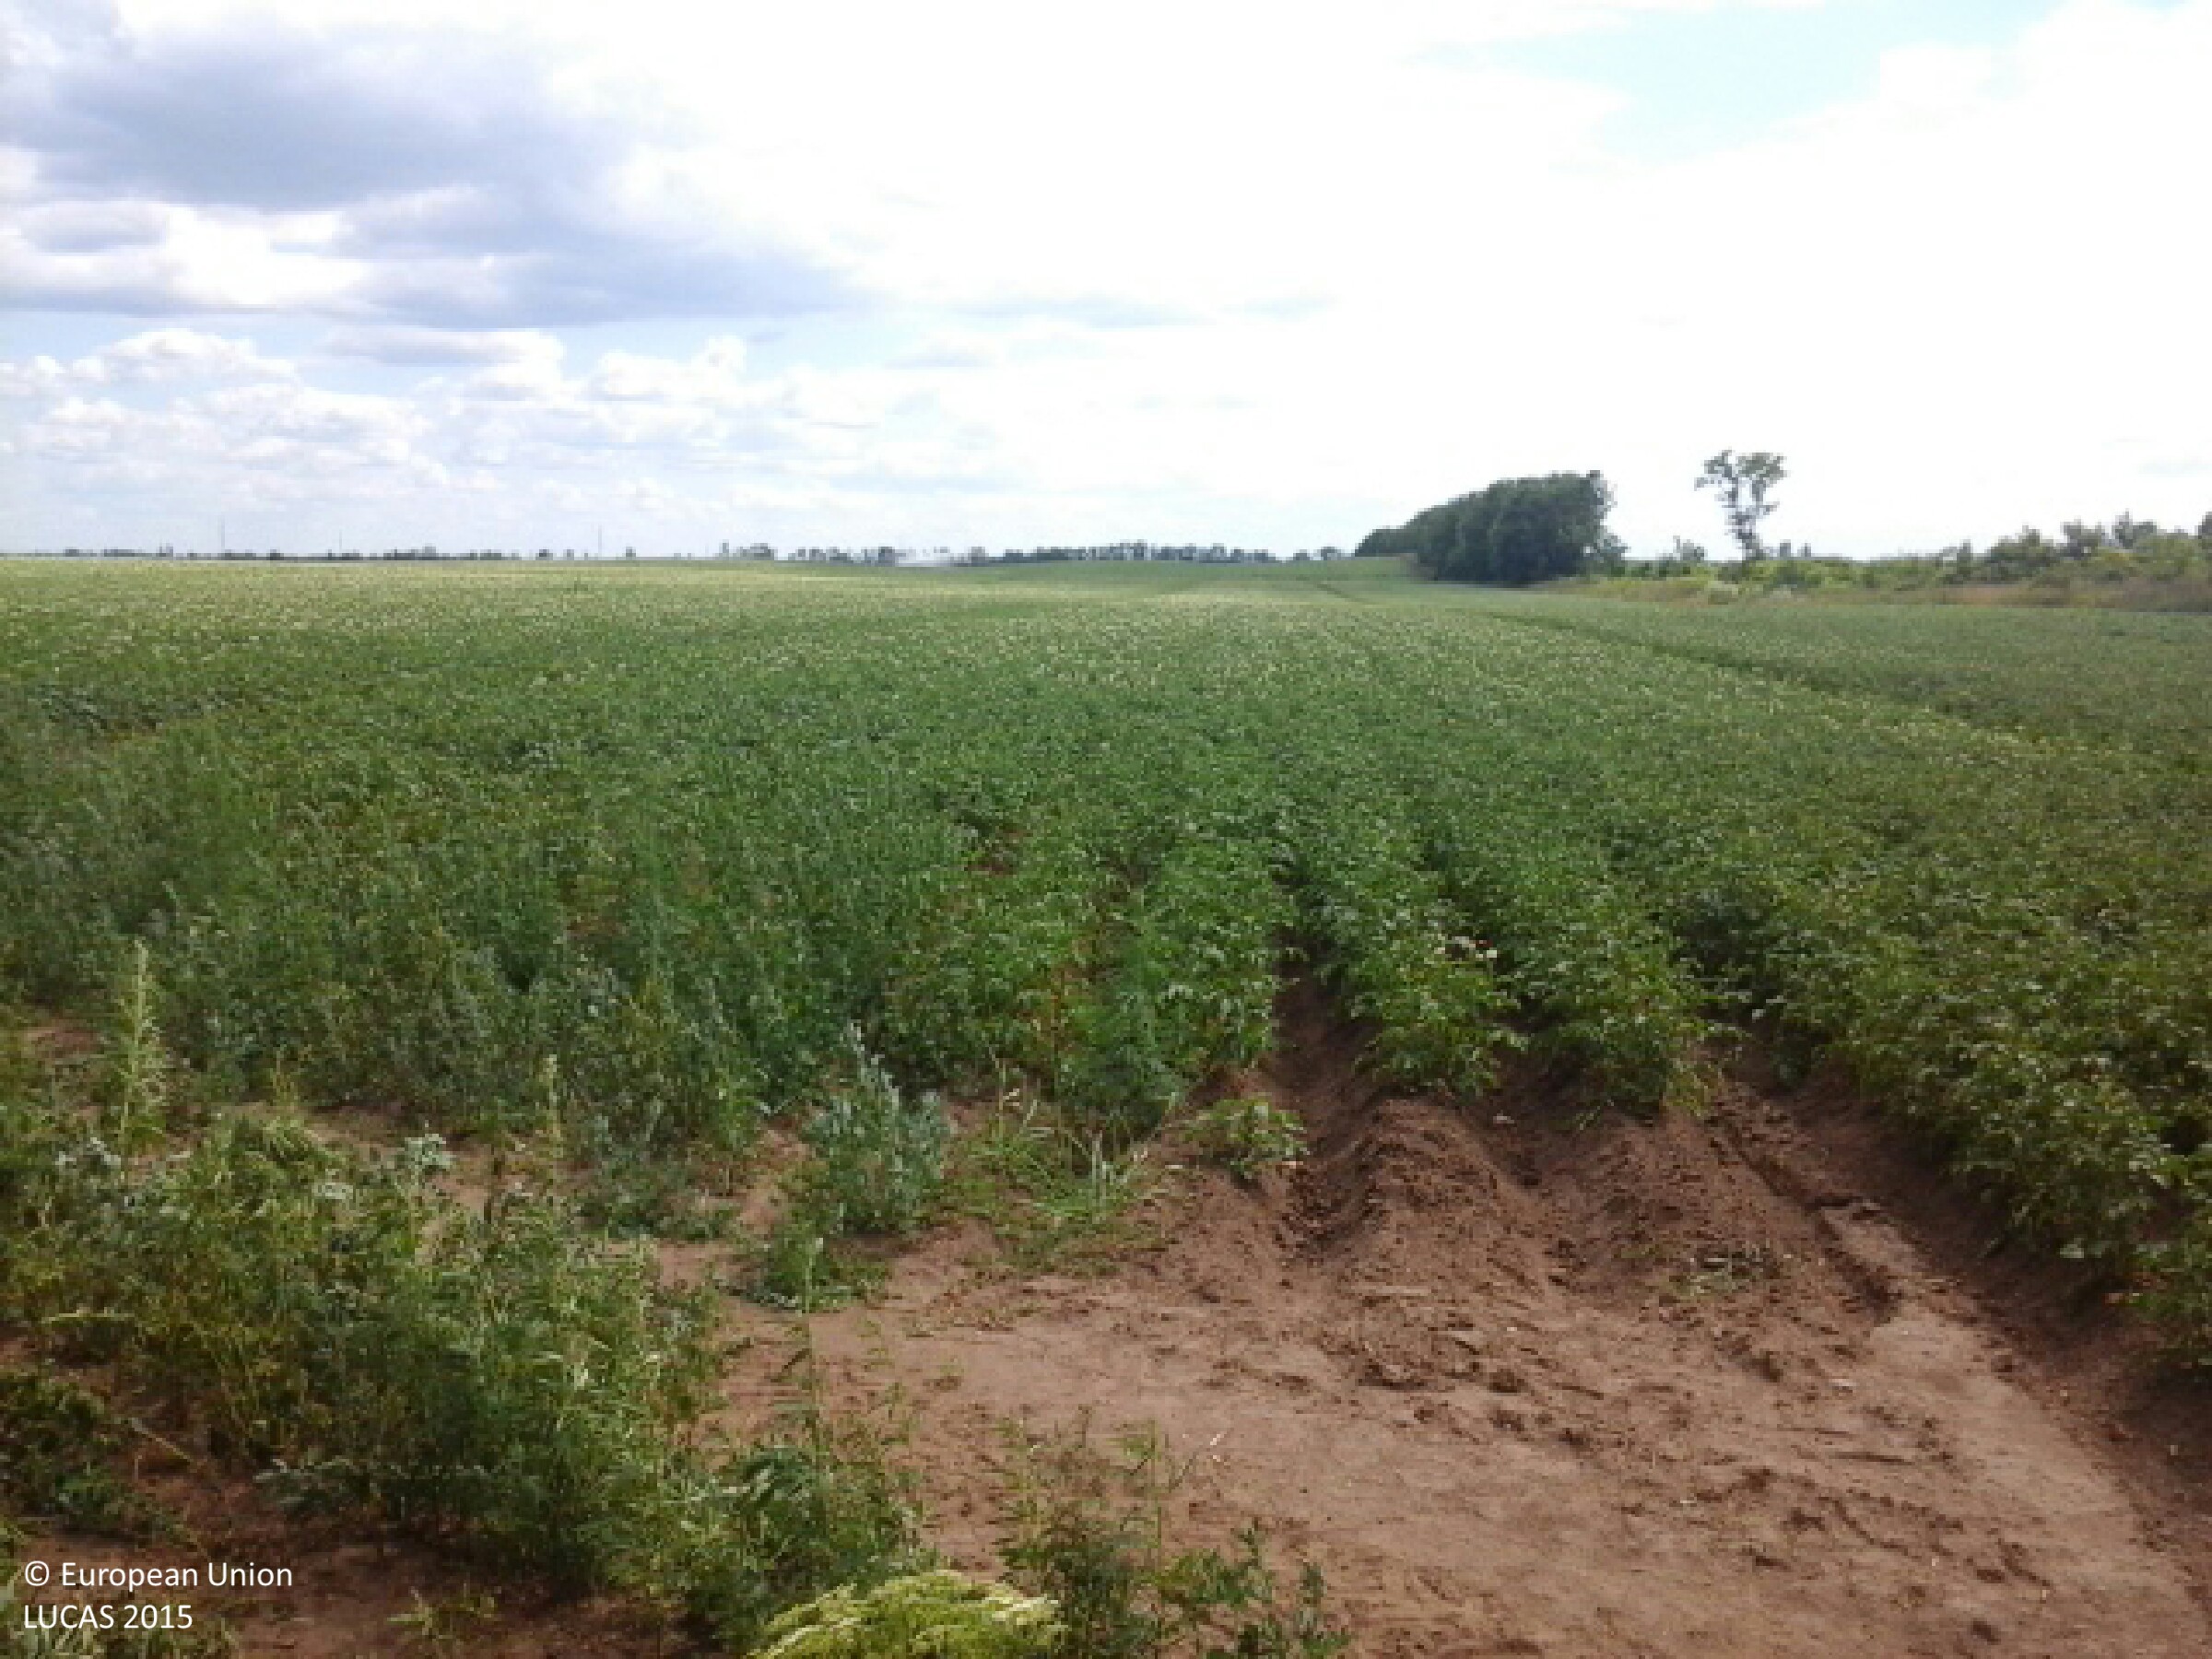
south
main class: Shrubland
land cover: Shrubland with sparse tree cover
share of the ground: 50 - 75 %
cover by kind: shrubs 70 %, herbaceous plants 25 %, broadleaved forest trees 5 %
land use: Road transport
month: June
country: HU
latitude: 48.0717
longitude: 21.5208
